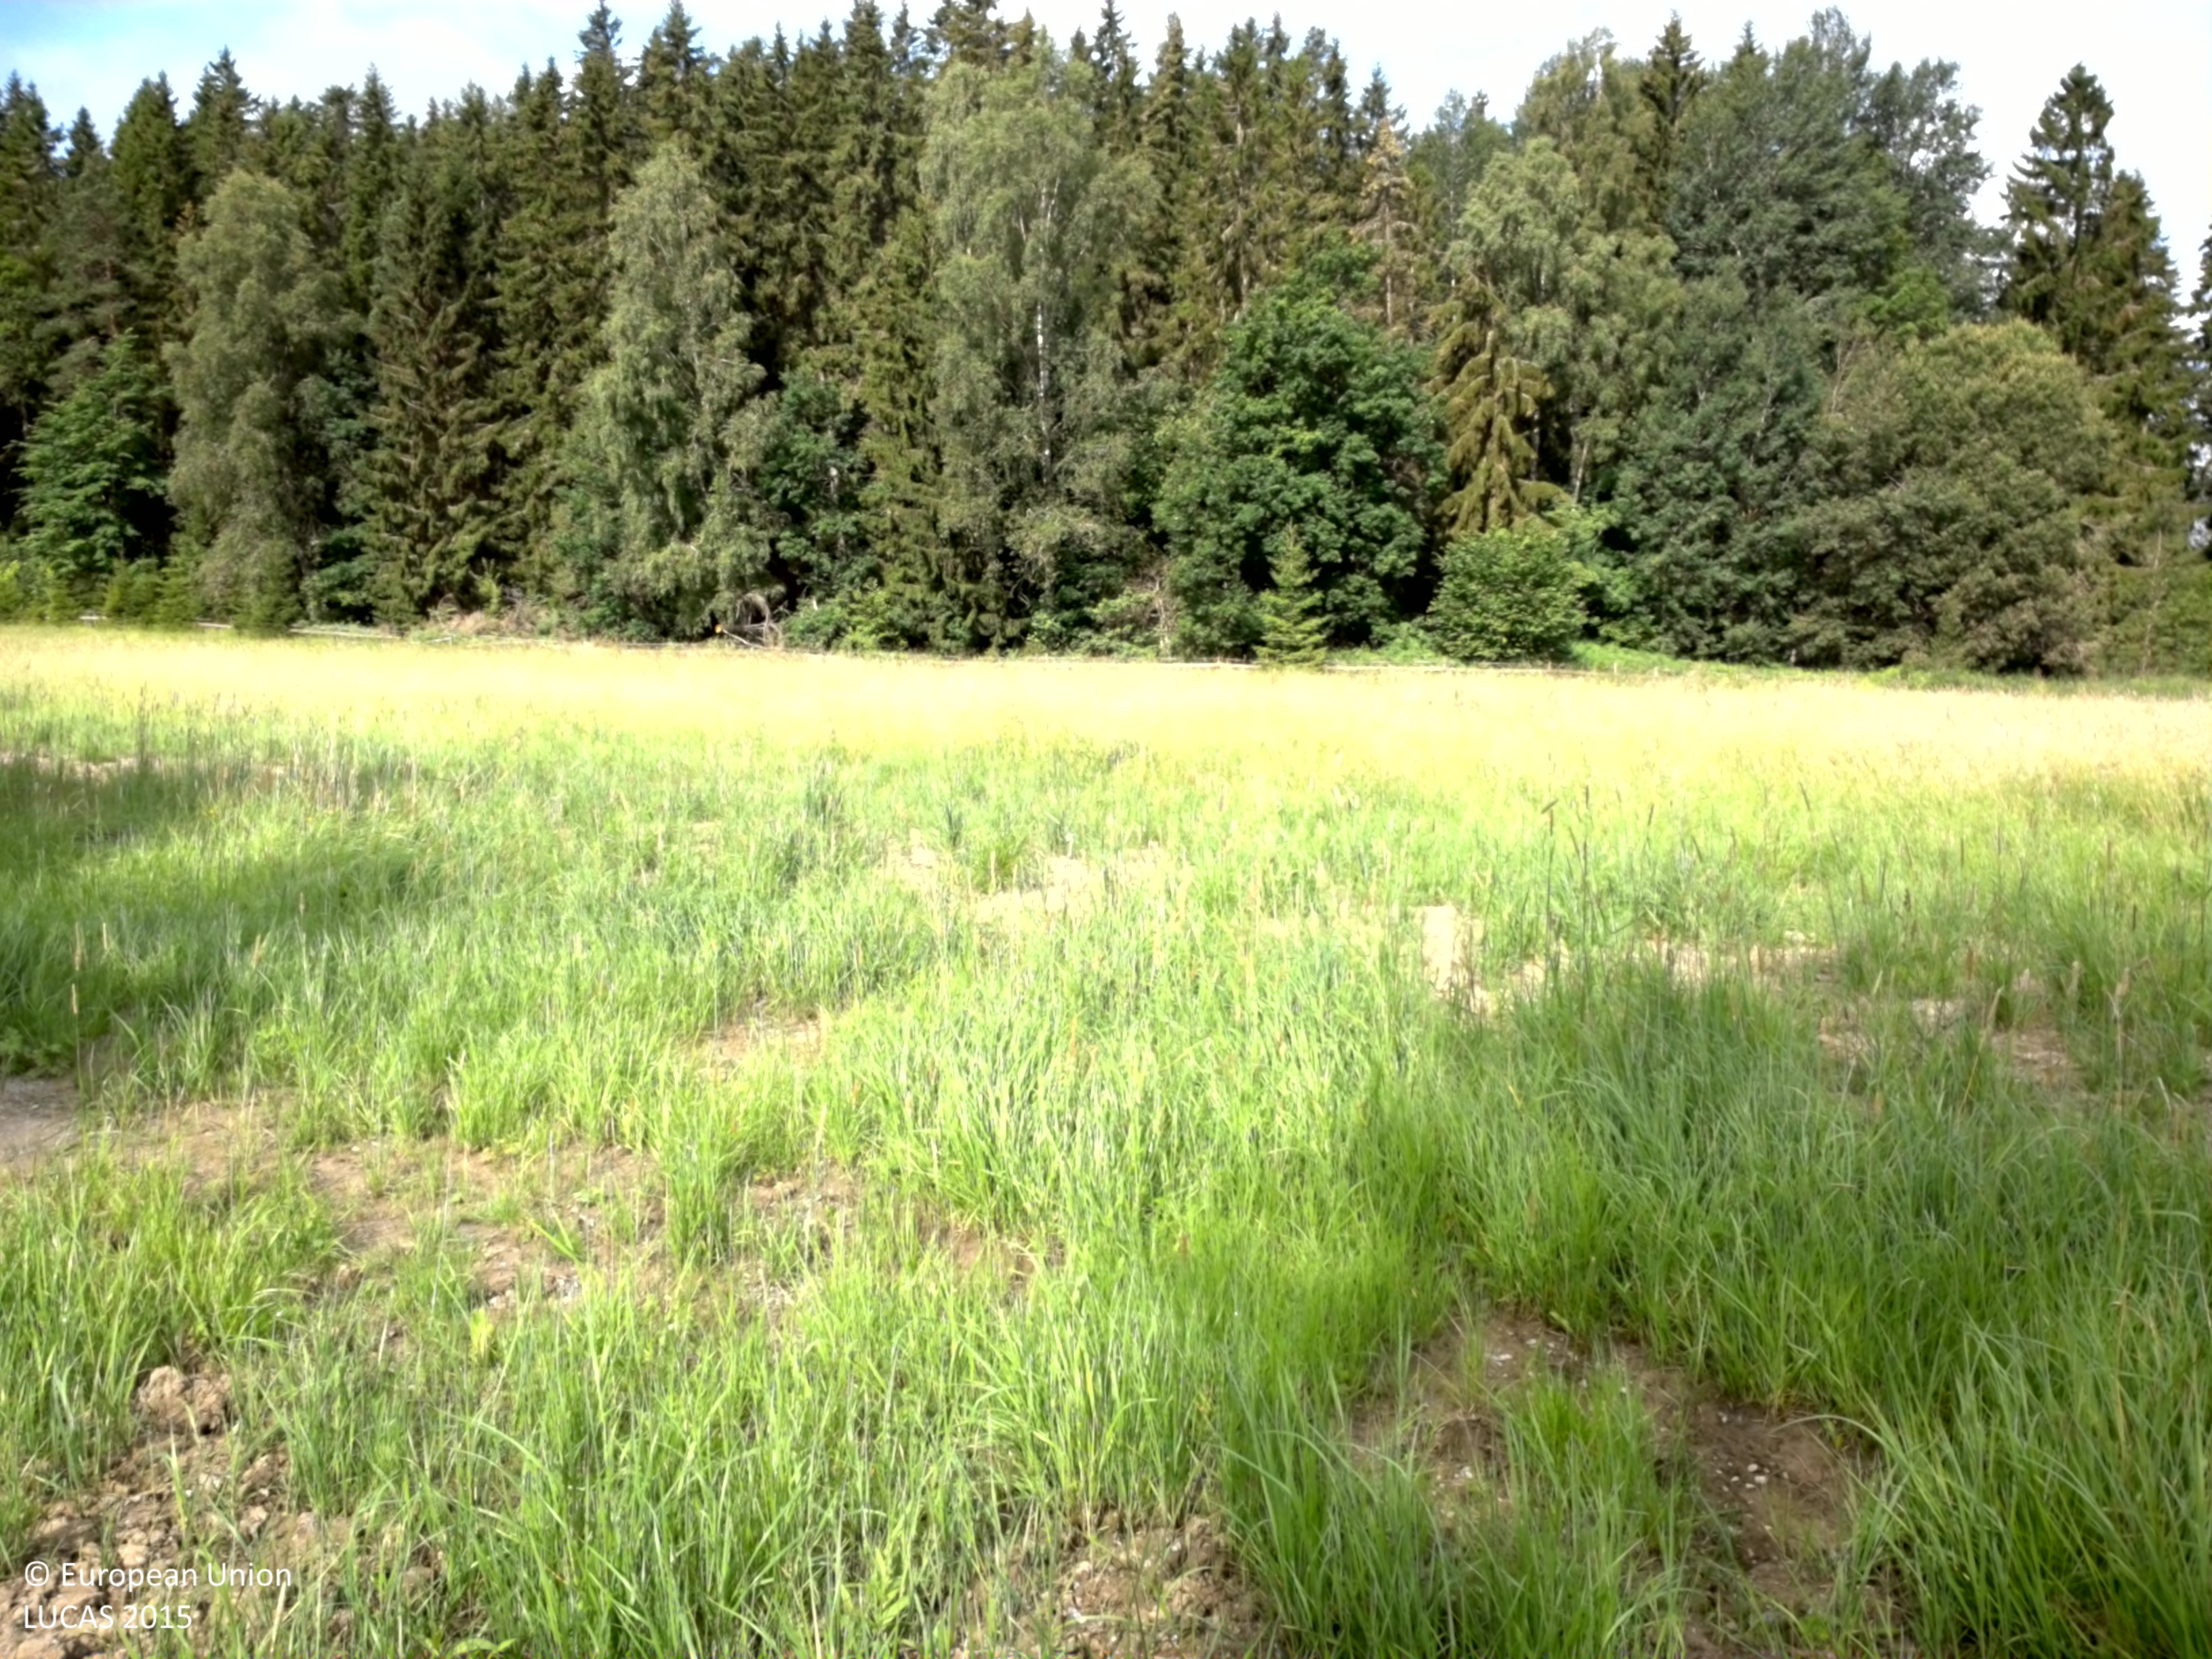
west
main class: Grassland
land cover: Grassland without tree/shrub cover
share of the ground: > 75 %
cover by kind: herbaceous plants 90 %, unconsolidated bare surface 10 %
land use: Agriculture (excluding fallow land and kitchen gardens)
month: July
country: SE
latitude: 59.7684
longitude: 18.6712
